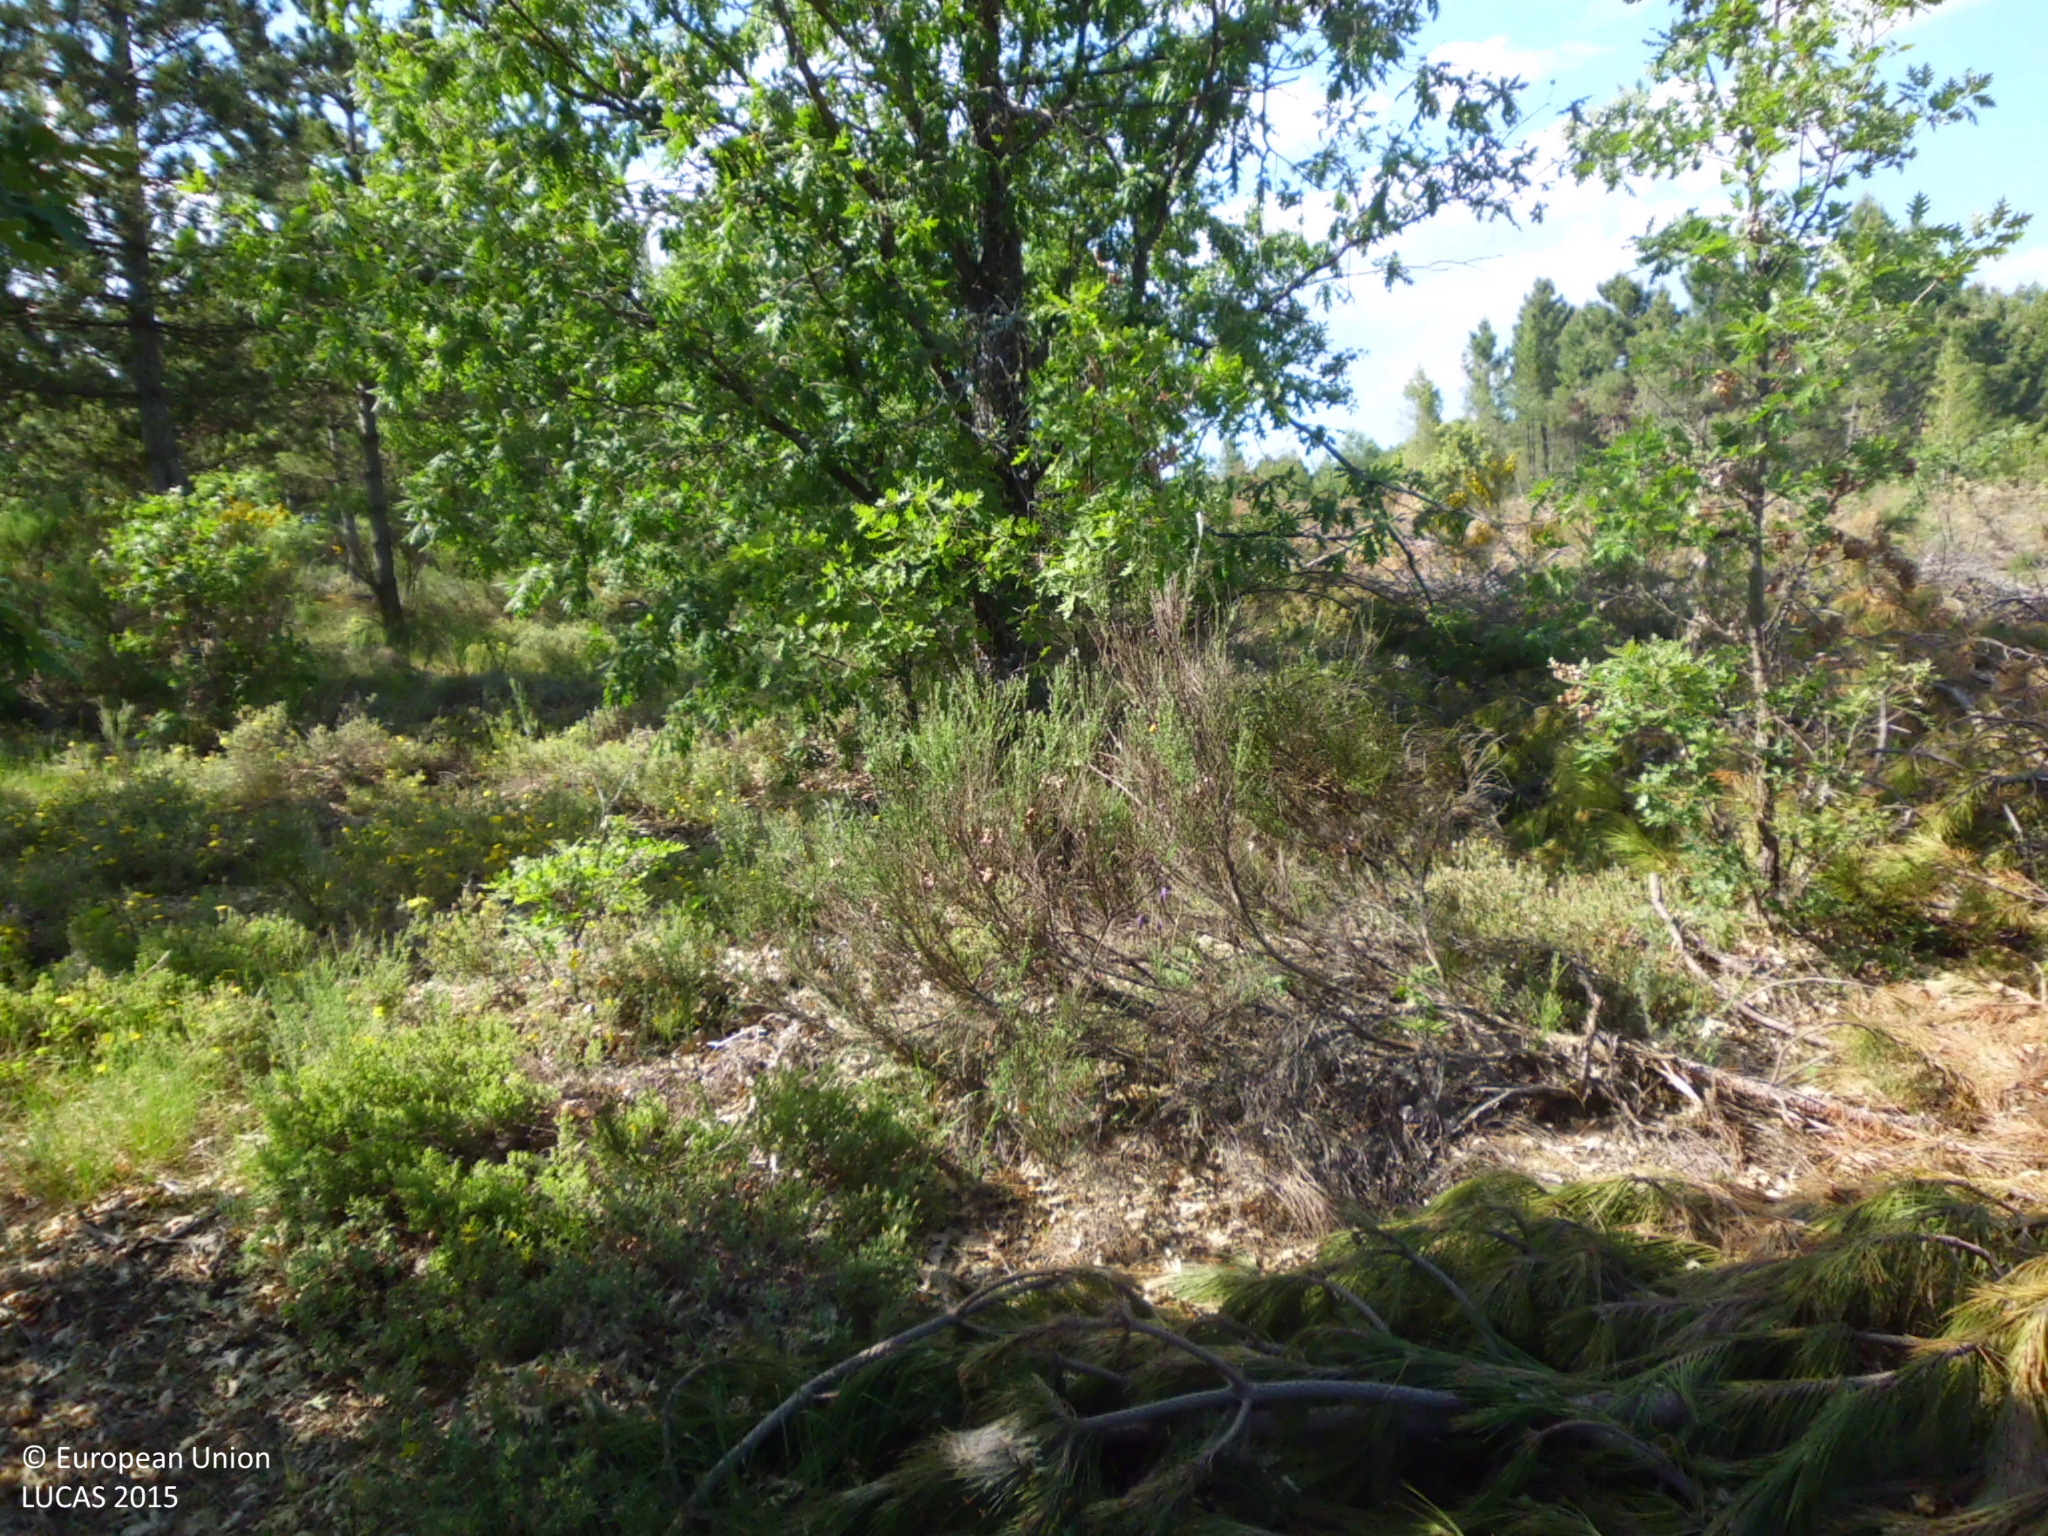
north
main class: Woodland
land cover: Pine dominated mixed woodland
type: coniferous forest of the mediterranean region
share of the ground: 50 - 75 %
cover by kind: coniferous forest trees 45 %, broadleaved forest trees 25 %, herbaceous plants 20 %, shrubs 10 %
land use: Forestry
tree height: > 5 m
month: May
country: ES
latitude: 42.7129
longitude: -5.4190
